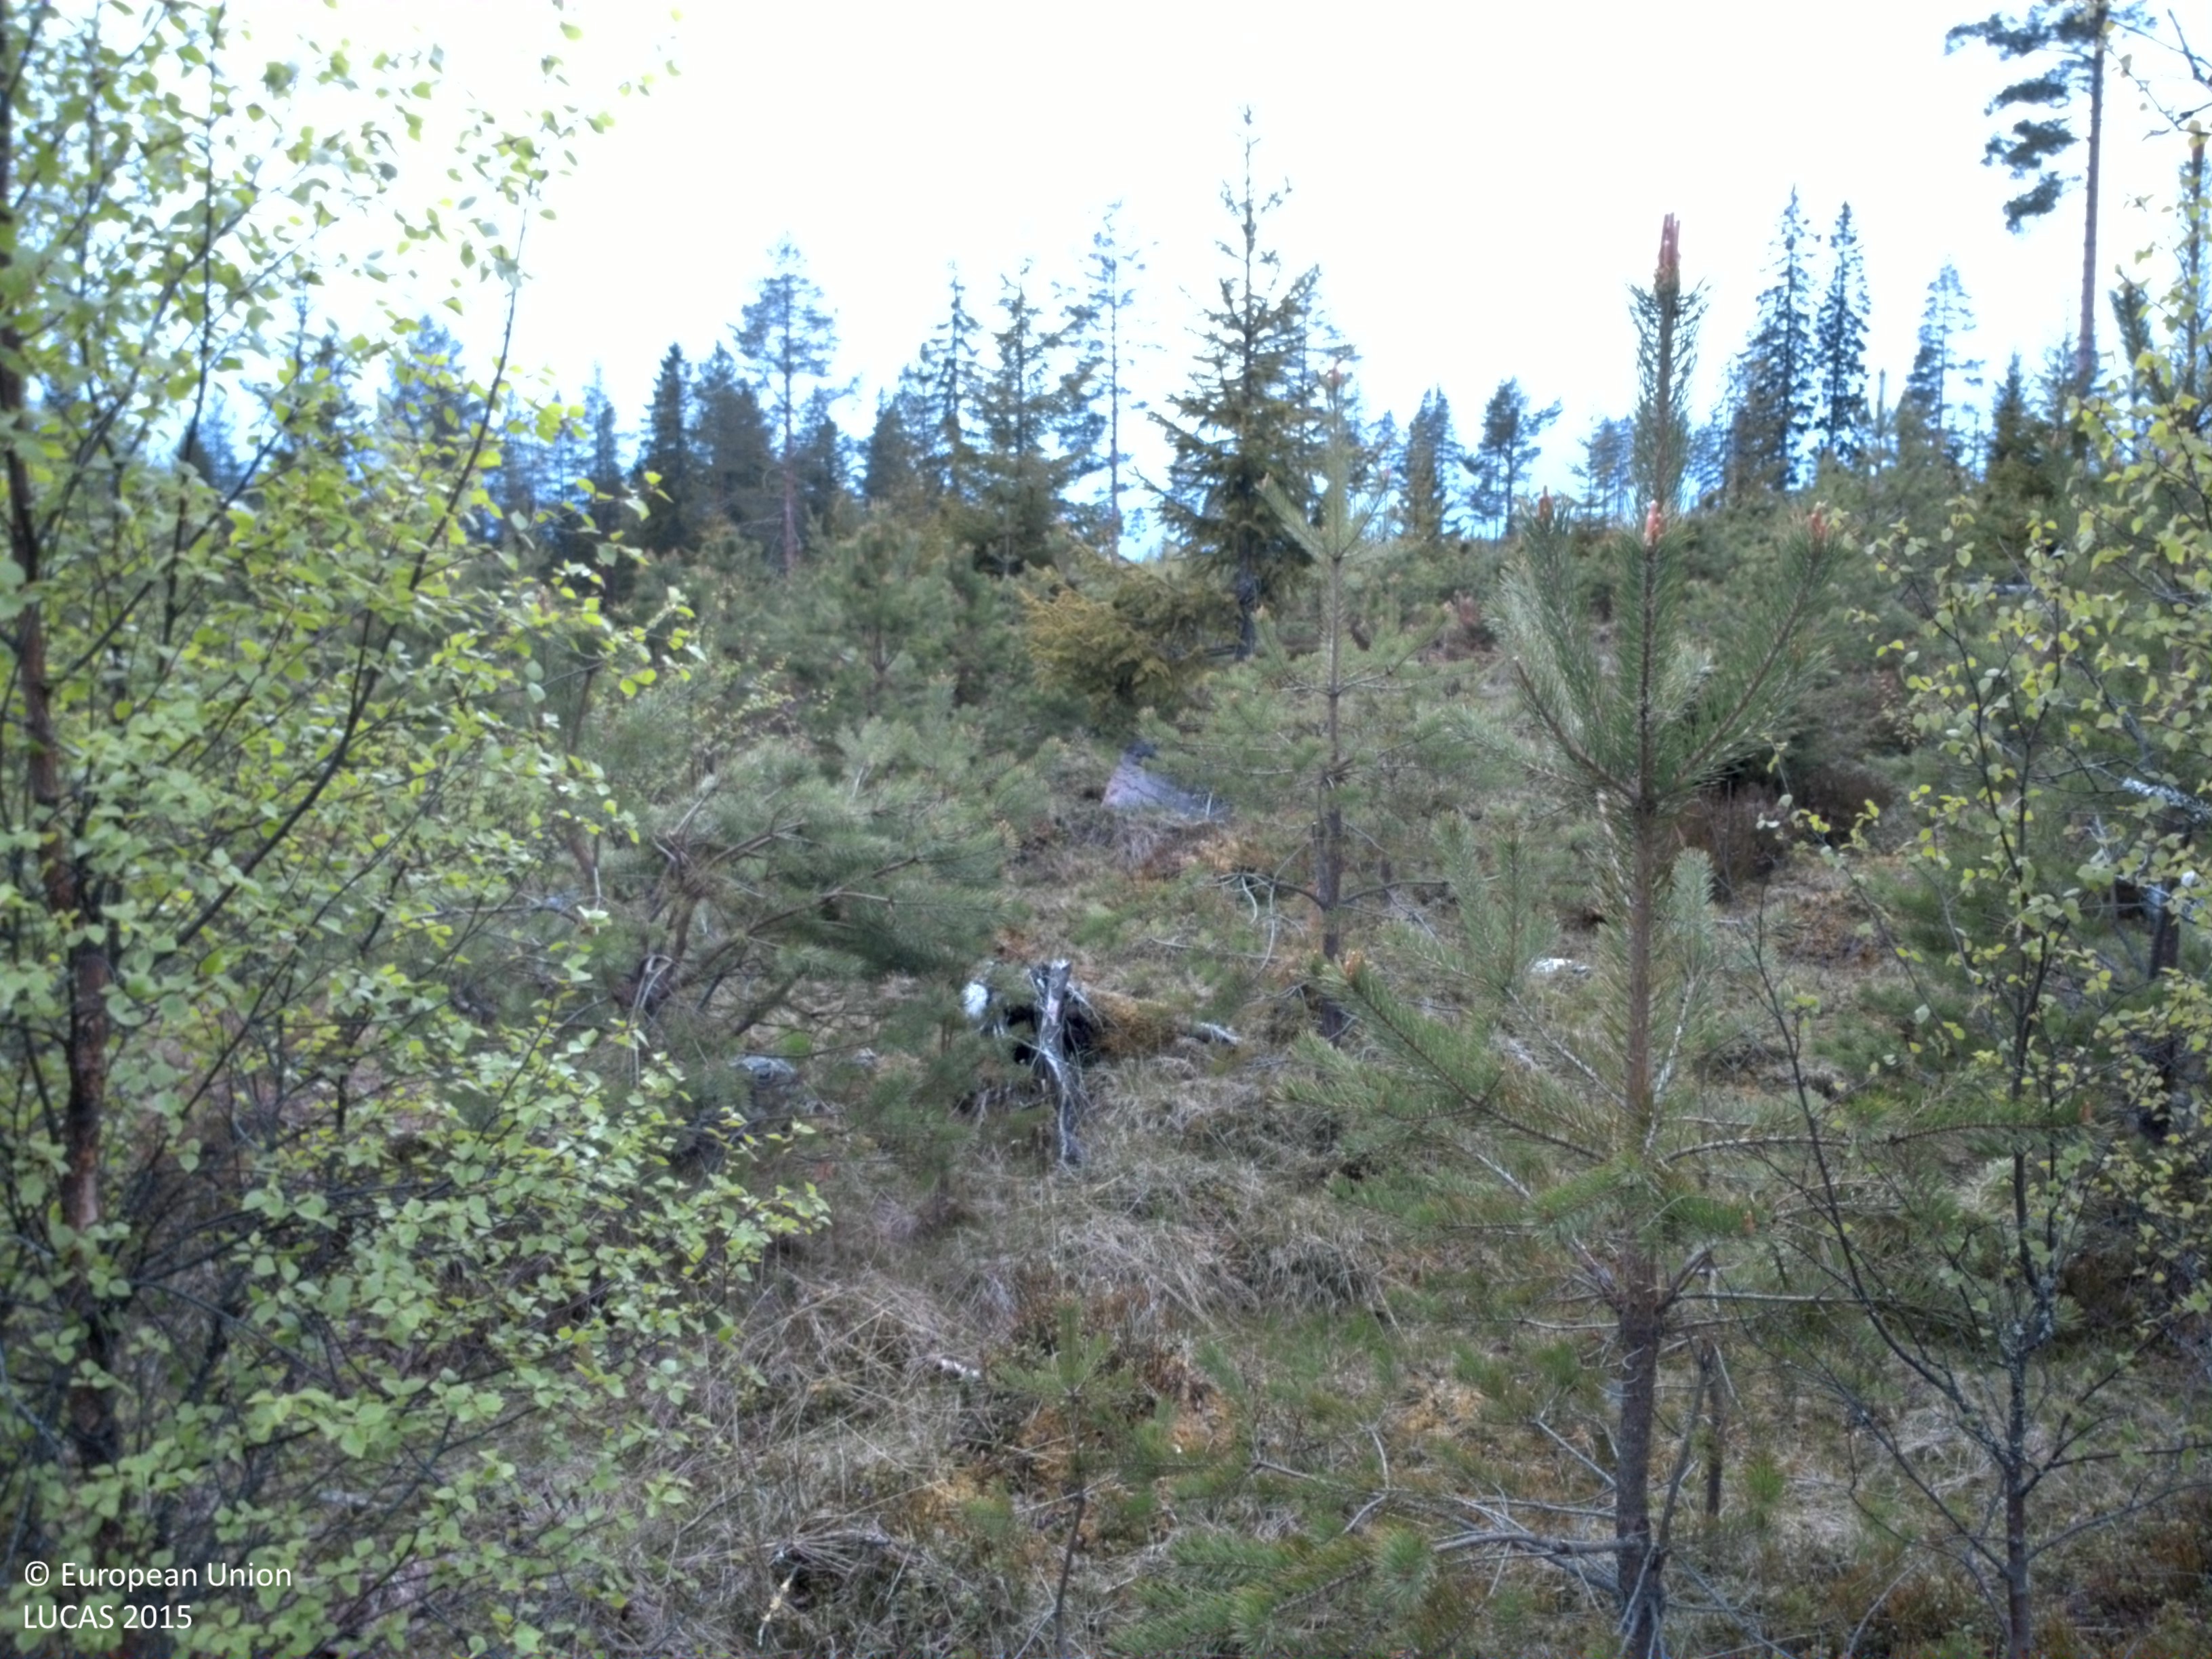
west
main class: Woodland
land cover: Pine dominated mixed woodland
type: boreal forest
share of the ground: 50 - 75 %
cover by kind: coniferous forest trees 50 %, broadleaved forest trees 25 %, herbaceous plants 25 %
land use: Forestry
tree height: < 5 m
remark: Clear cut
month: May
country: SE
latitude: 61.1608
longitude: 15.3935
